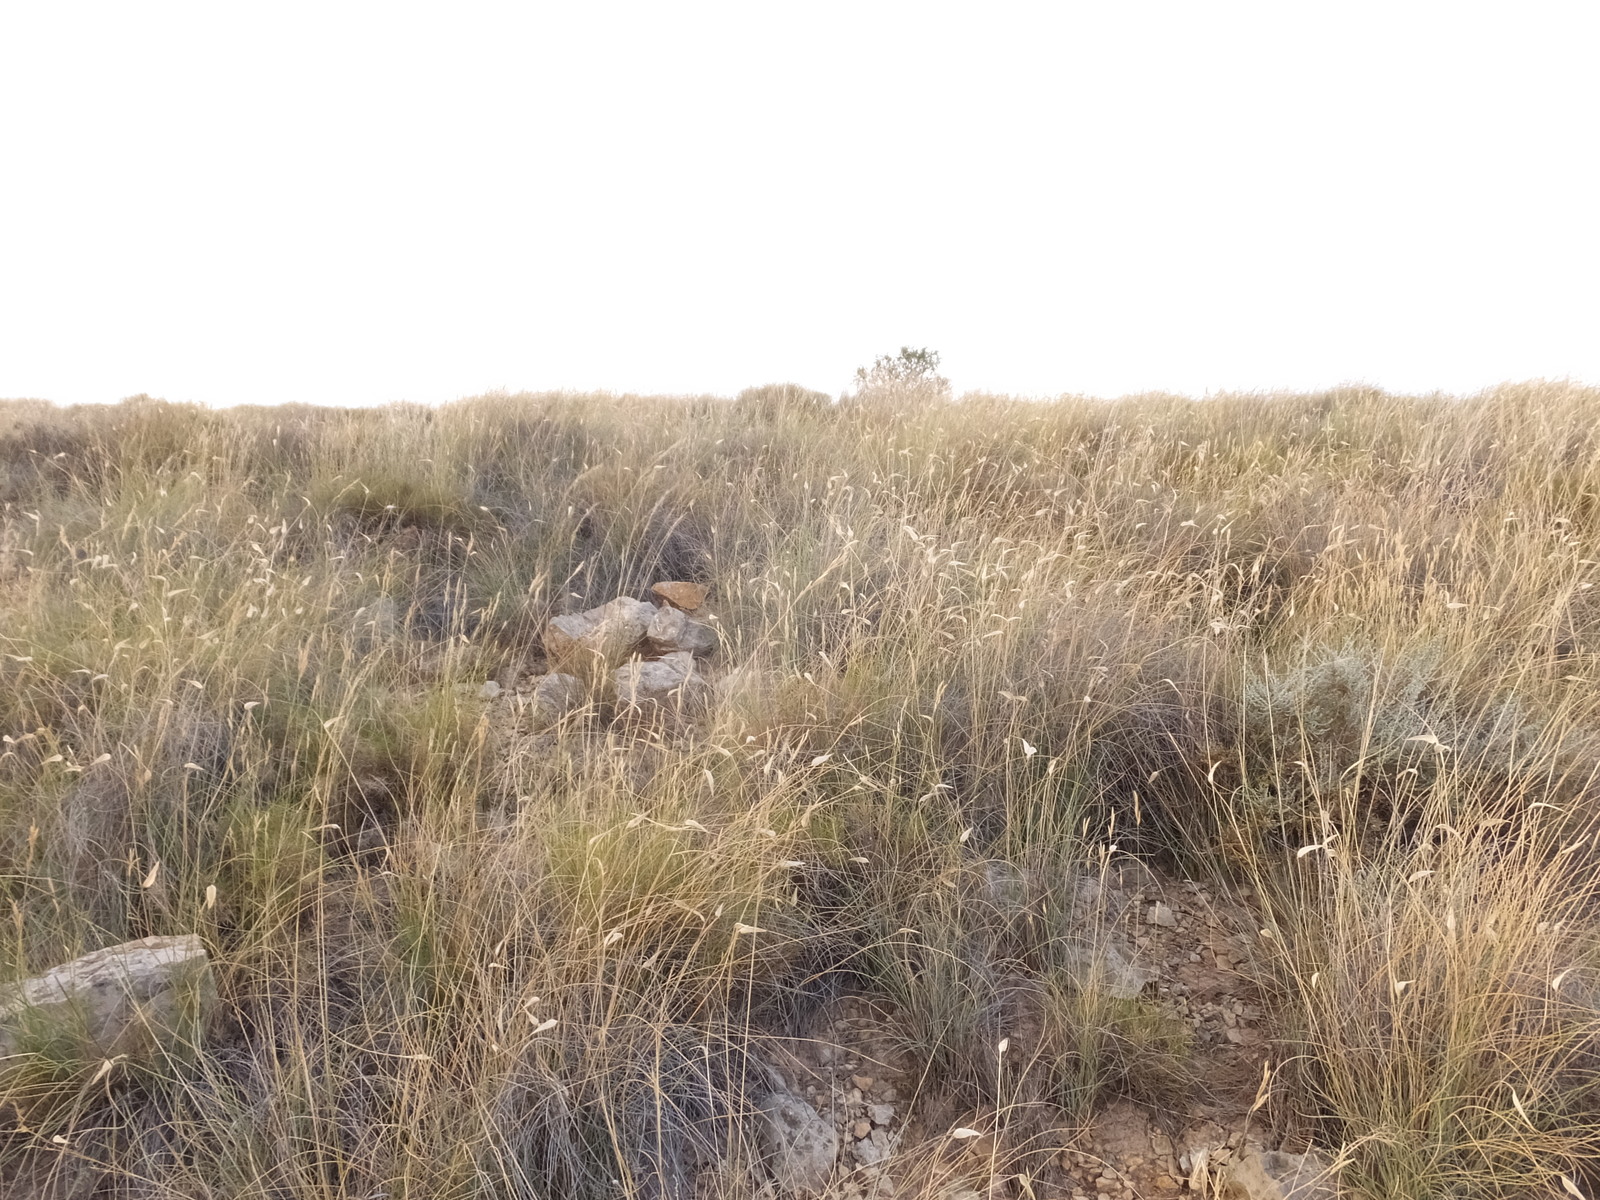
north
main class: Shrubland
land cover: Shrubland without tree cover
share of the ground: 50 - 75 %
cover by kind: shrubs 50 %, herbaceous plants 40 %, consolidated bare surface 10 %
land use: Semi-natural and natural areas not in use
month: June
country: ES
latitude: 41.6696
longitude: 0.0272
